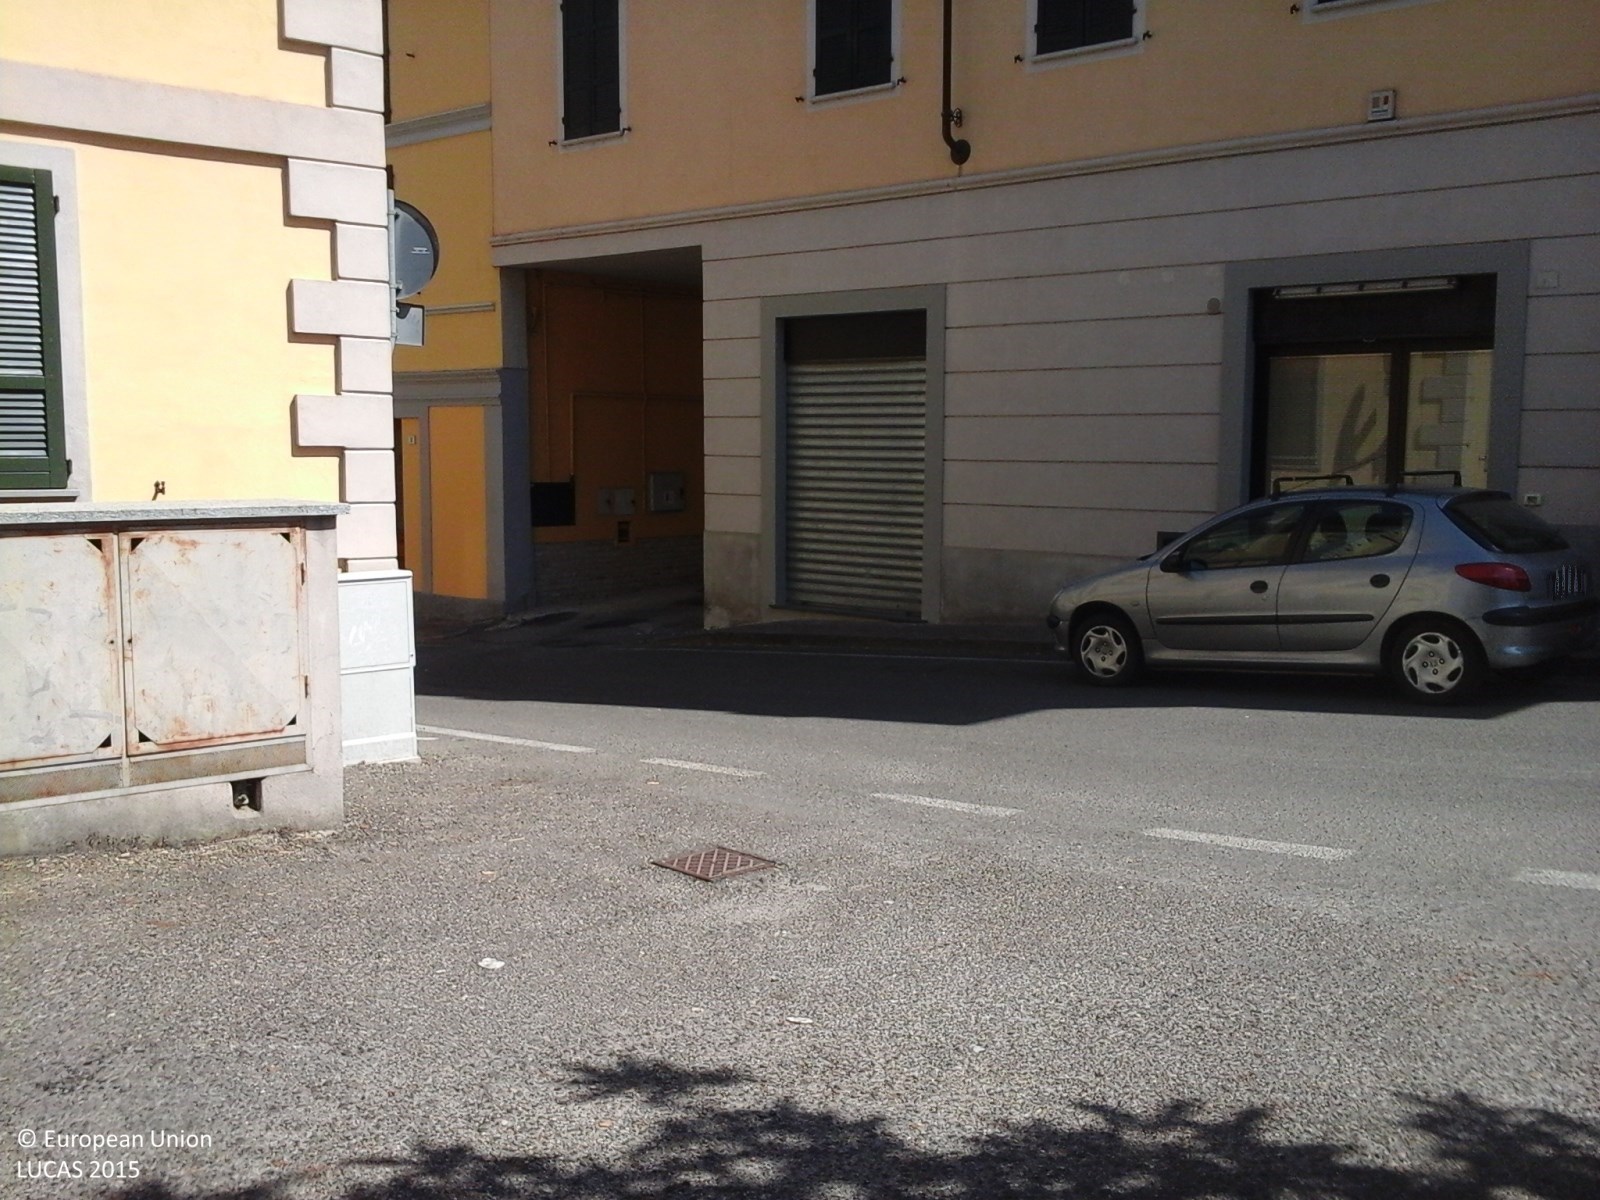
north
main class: Grassland
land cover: Grassland without tree/shrub cover
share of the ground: > 75 %
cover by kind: herbaceous plants 100 %
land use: Residential
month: July
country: IT
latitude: 45.0141
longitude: 9.1262
